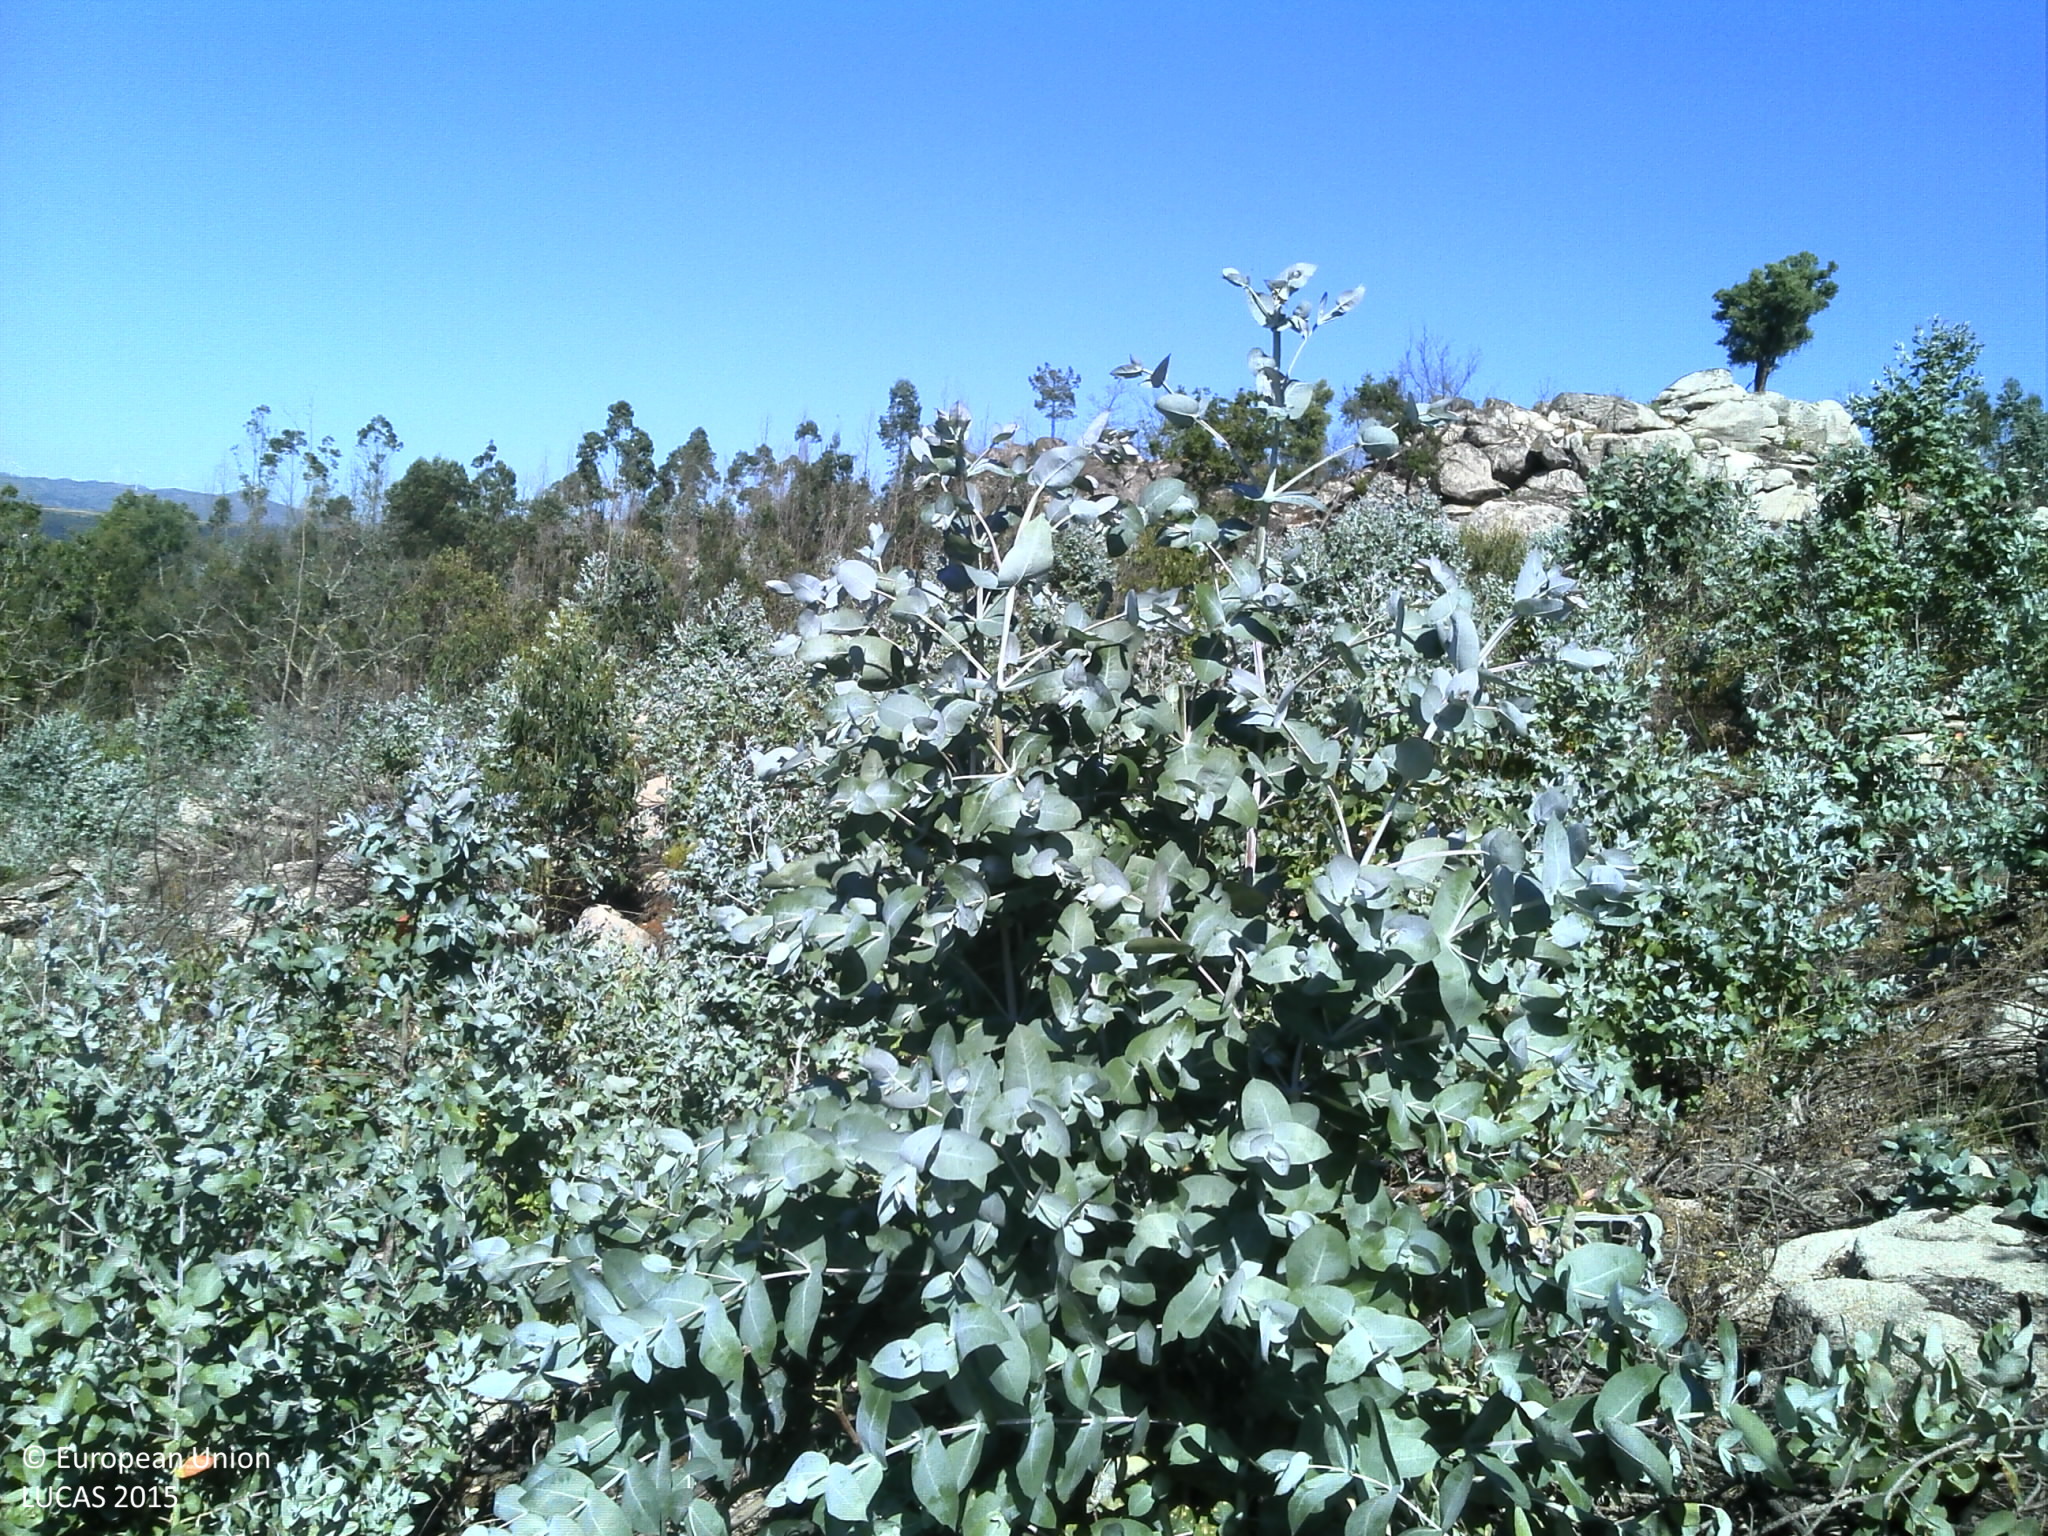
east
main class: Woodland
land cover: Broadleaved woodland
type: exotic forest
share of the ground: 25 - 50 %
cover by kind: broadleaved forest trees 50 %, unconsolidated bare surface 25 %, consolidated bare surface 20 %, shrubs 5 %
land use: Forestry
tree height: < 5 m
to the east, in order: Broadleaved woodland; Shrubland without tree cover; Rock outcrops; Shrubland with sparse tree cover; Broadleaved woodland
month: June
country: PT
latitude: 40.5919
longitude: -8.2461
